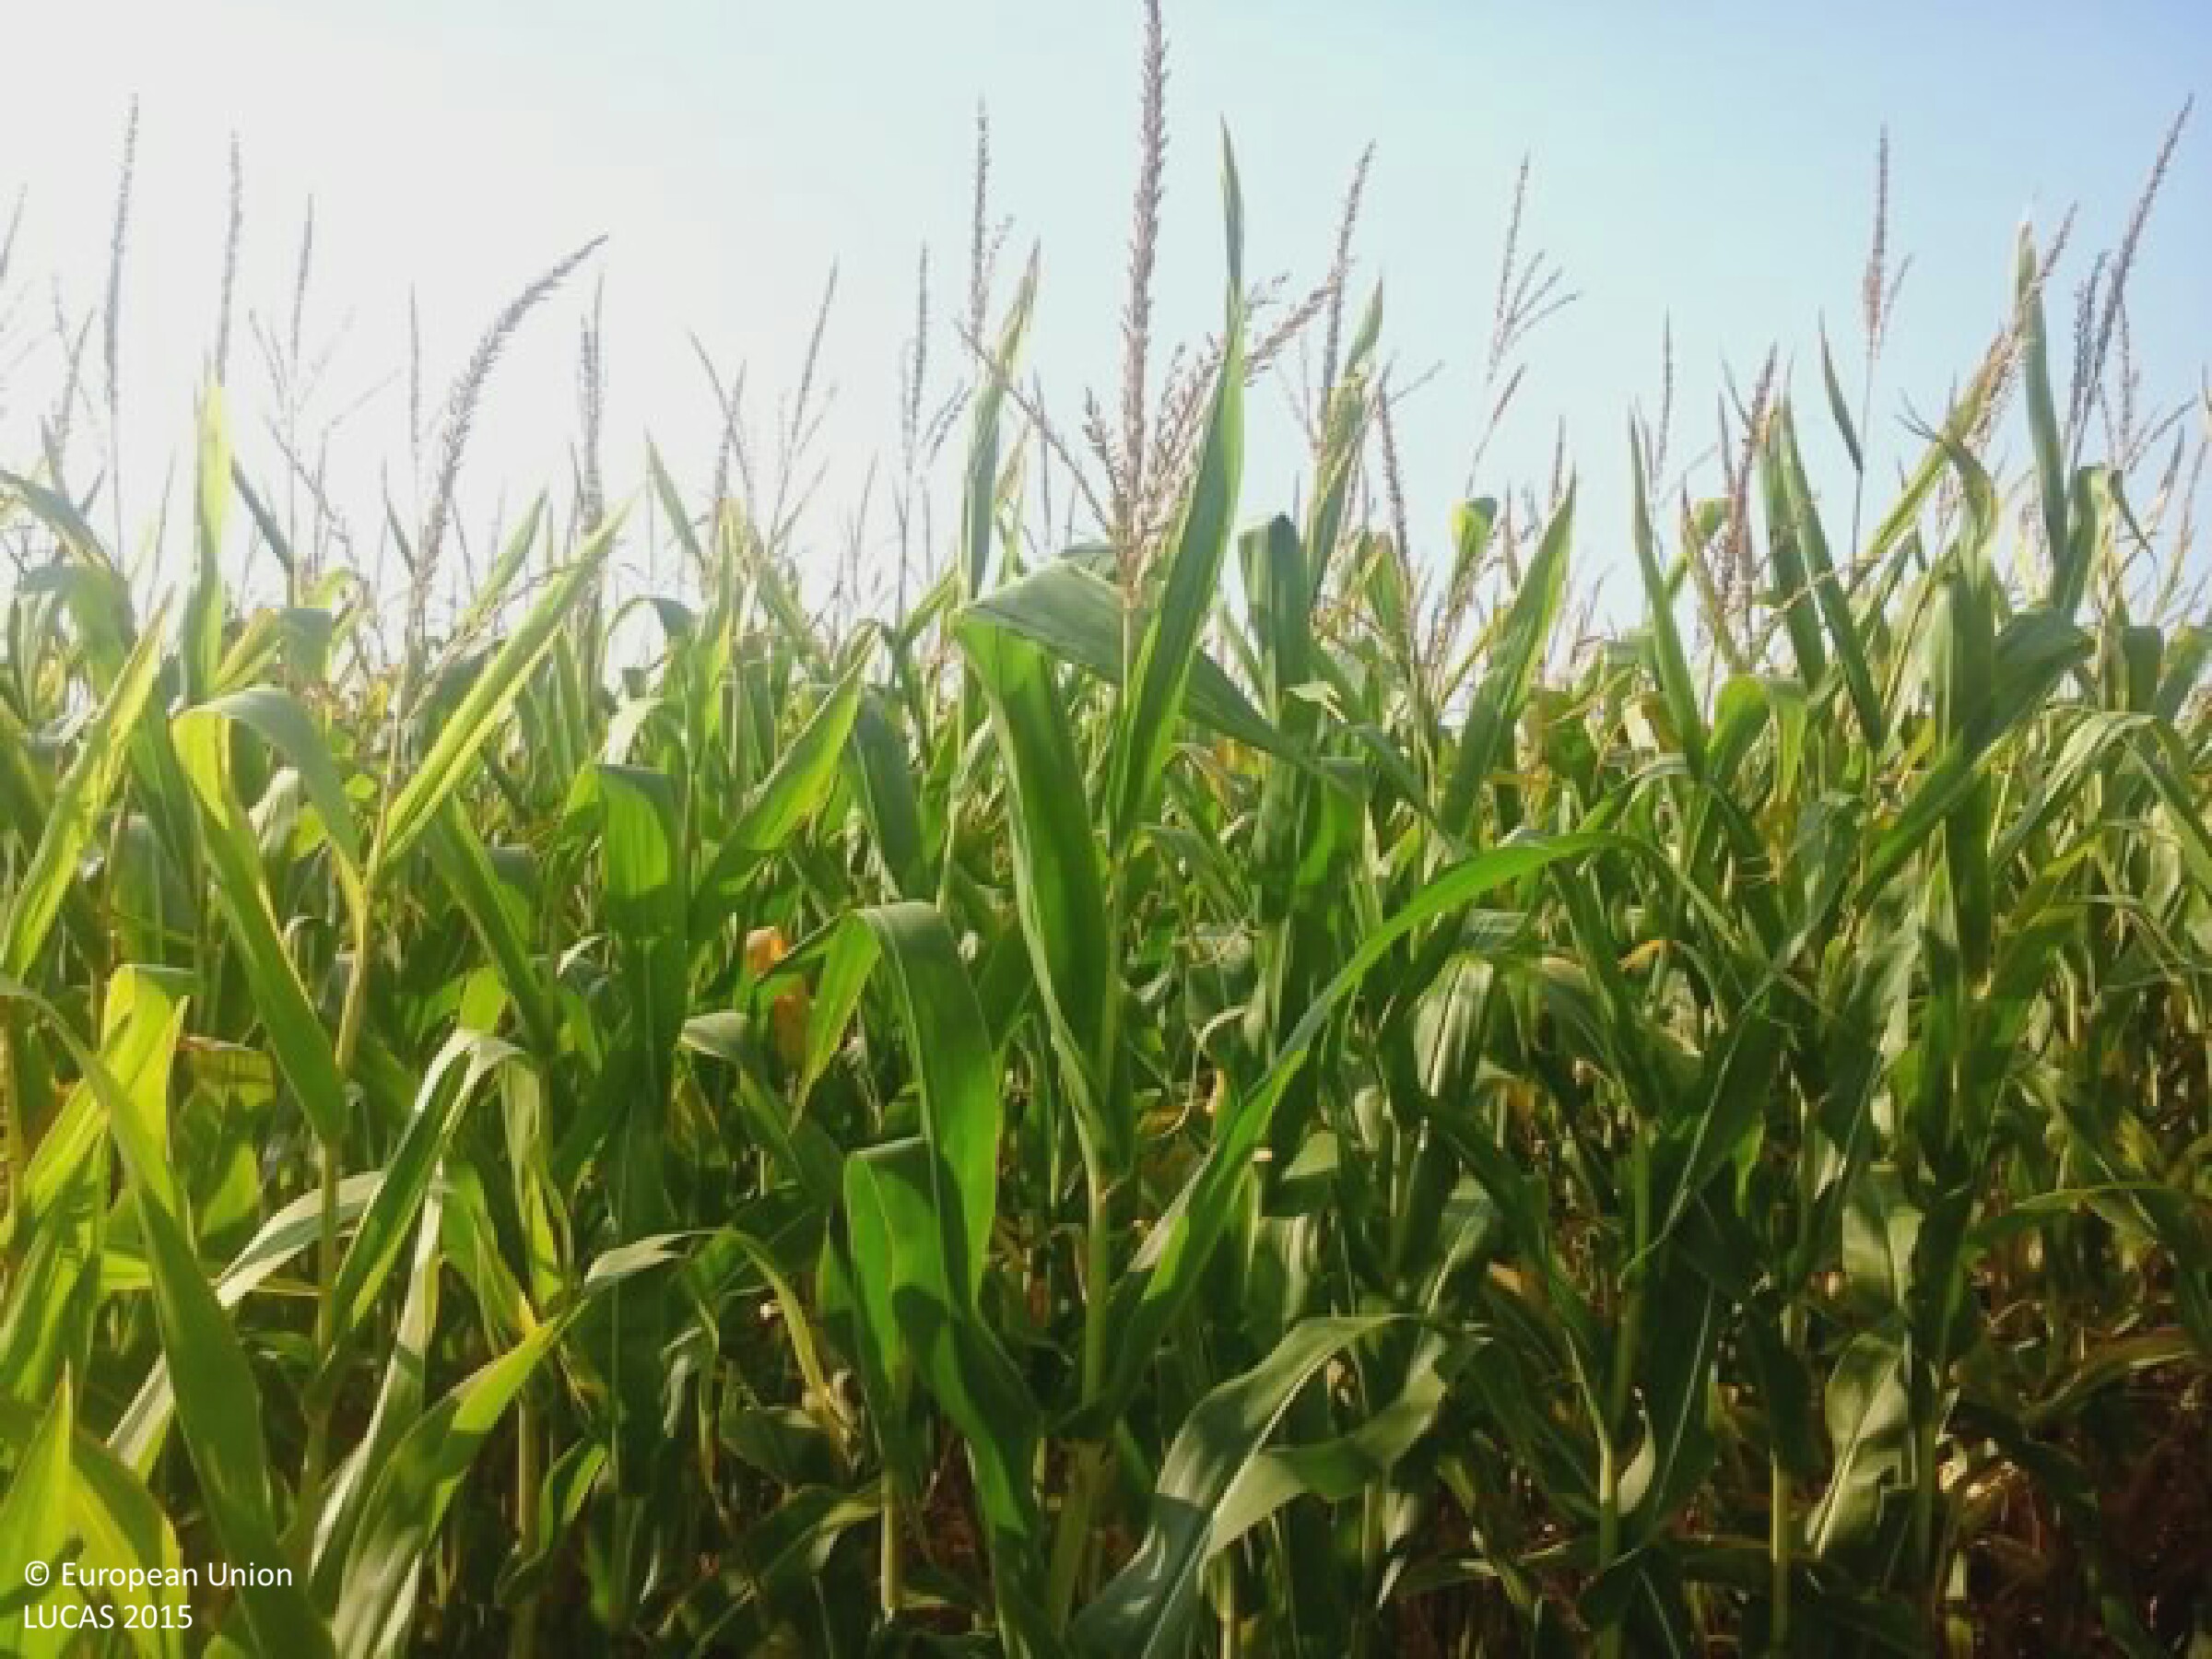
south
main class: Cropland
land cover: Maize
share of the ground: > 75 %
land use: Agriculture (excluding fallow land and kitchen gardens)
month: August
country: HU
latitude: 46.3908
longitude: 18.0570
